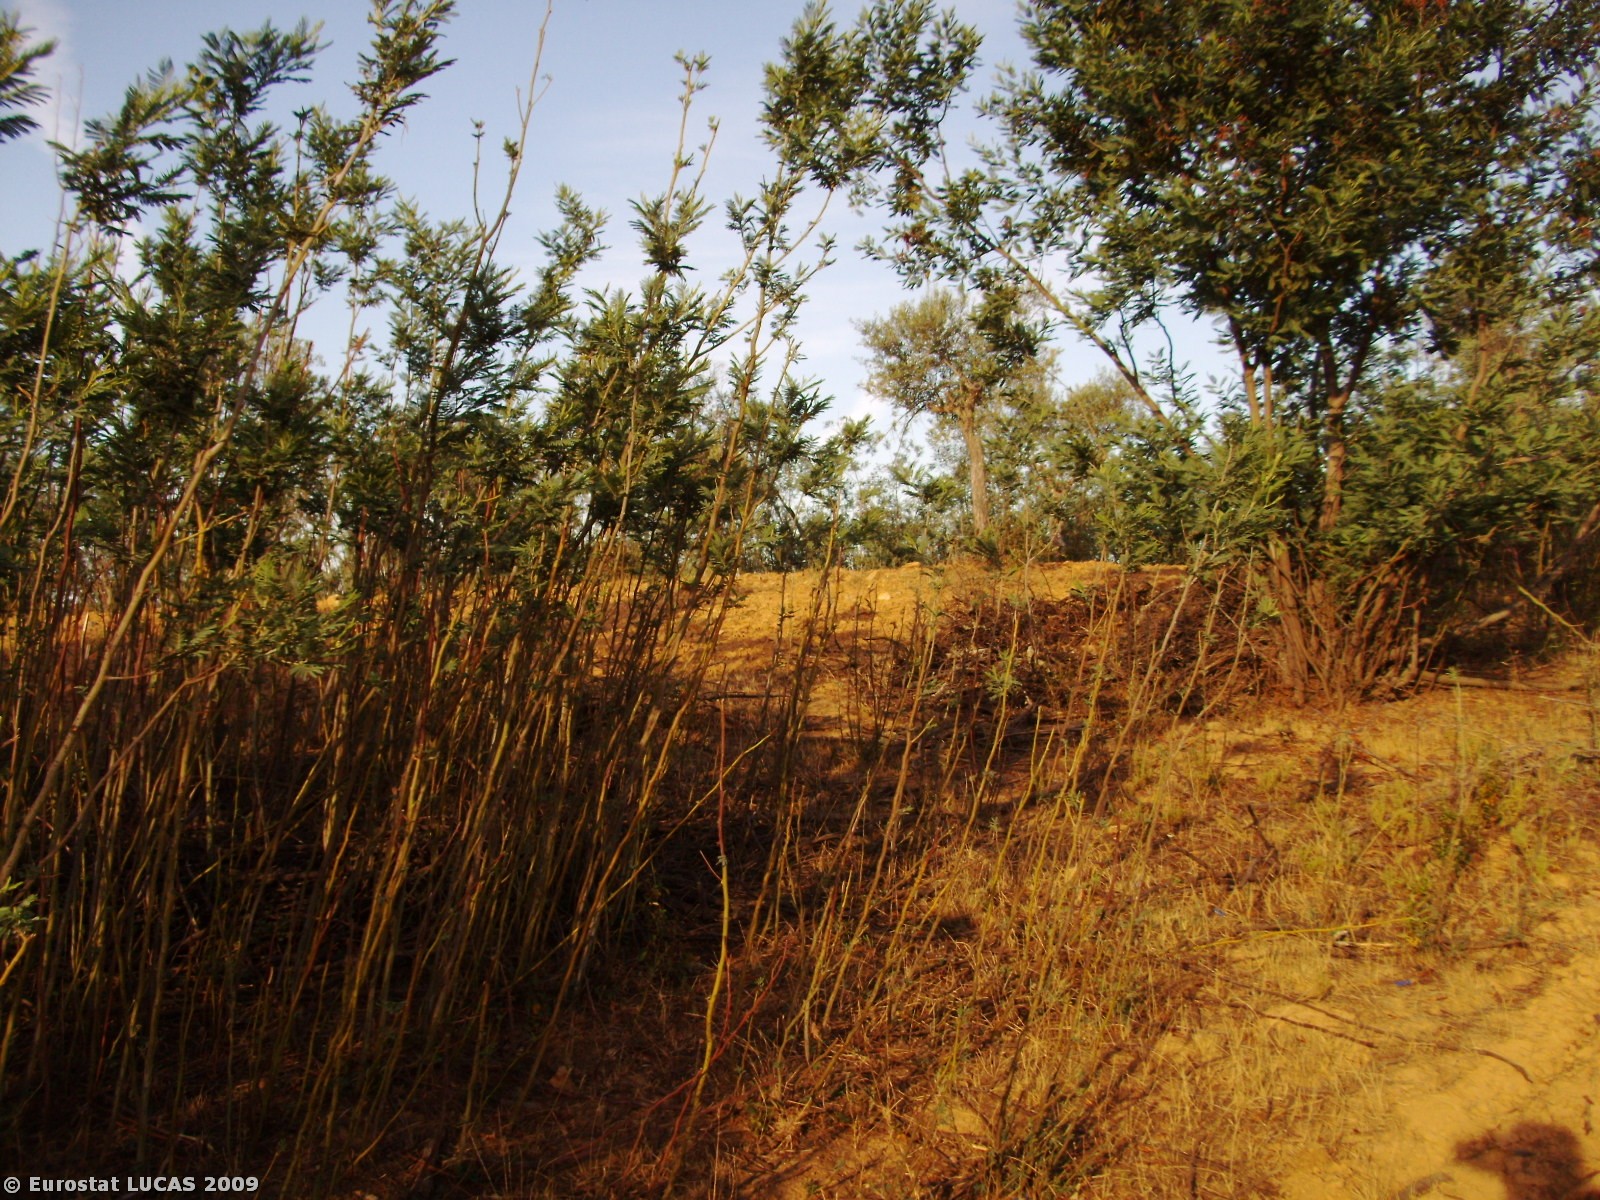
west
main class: Cropland
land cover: Olive groves
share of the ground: 50 - 75 %
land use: Agriculture (excluding fallow land and kitchen gardens)
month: June
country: PT
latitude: 40.0768
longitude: -7.2294
